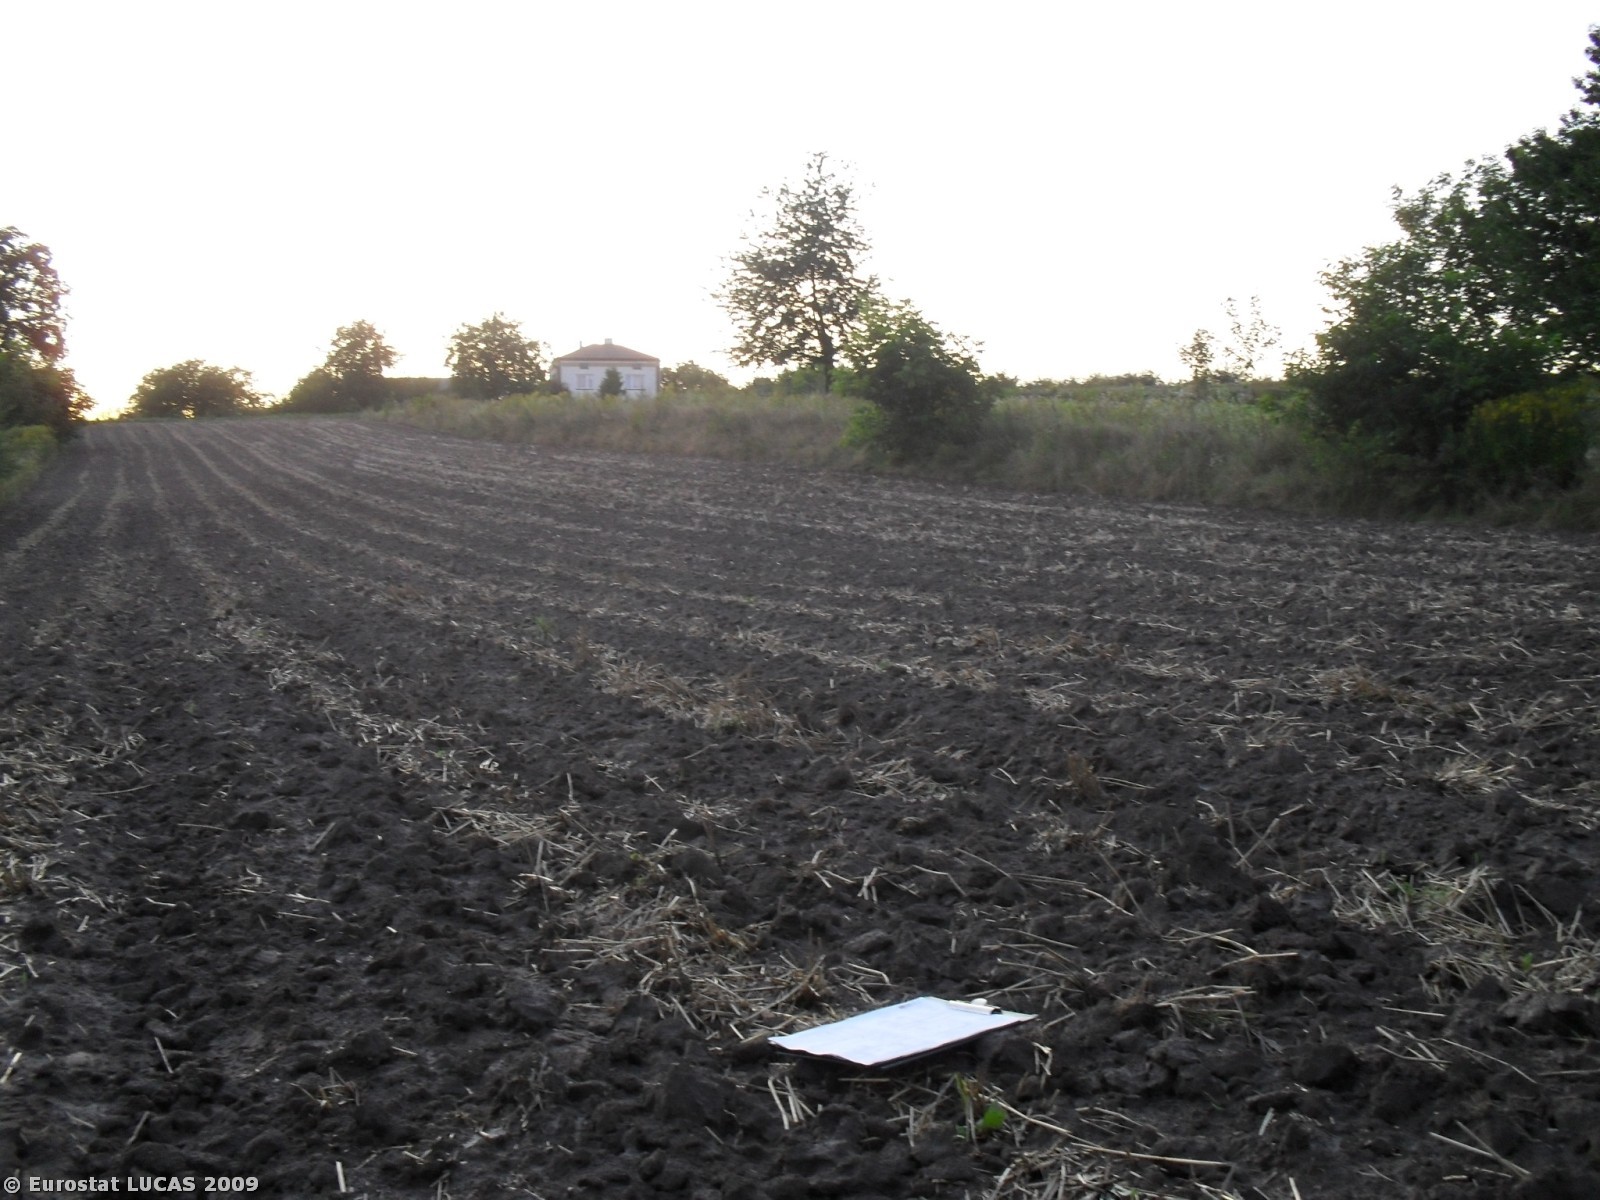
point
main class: Cropland
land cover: Common wheat
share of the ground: < 10 %
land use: Agriculture (excluding fallow land and kitchen gardens)
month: August
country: PL
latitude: 51.3106
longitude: 22.0088
